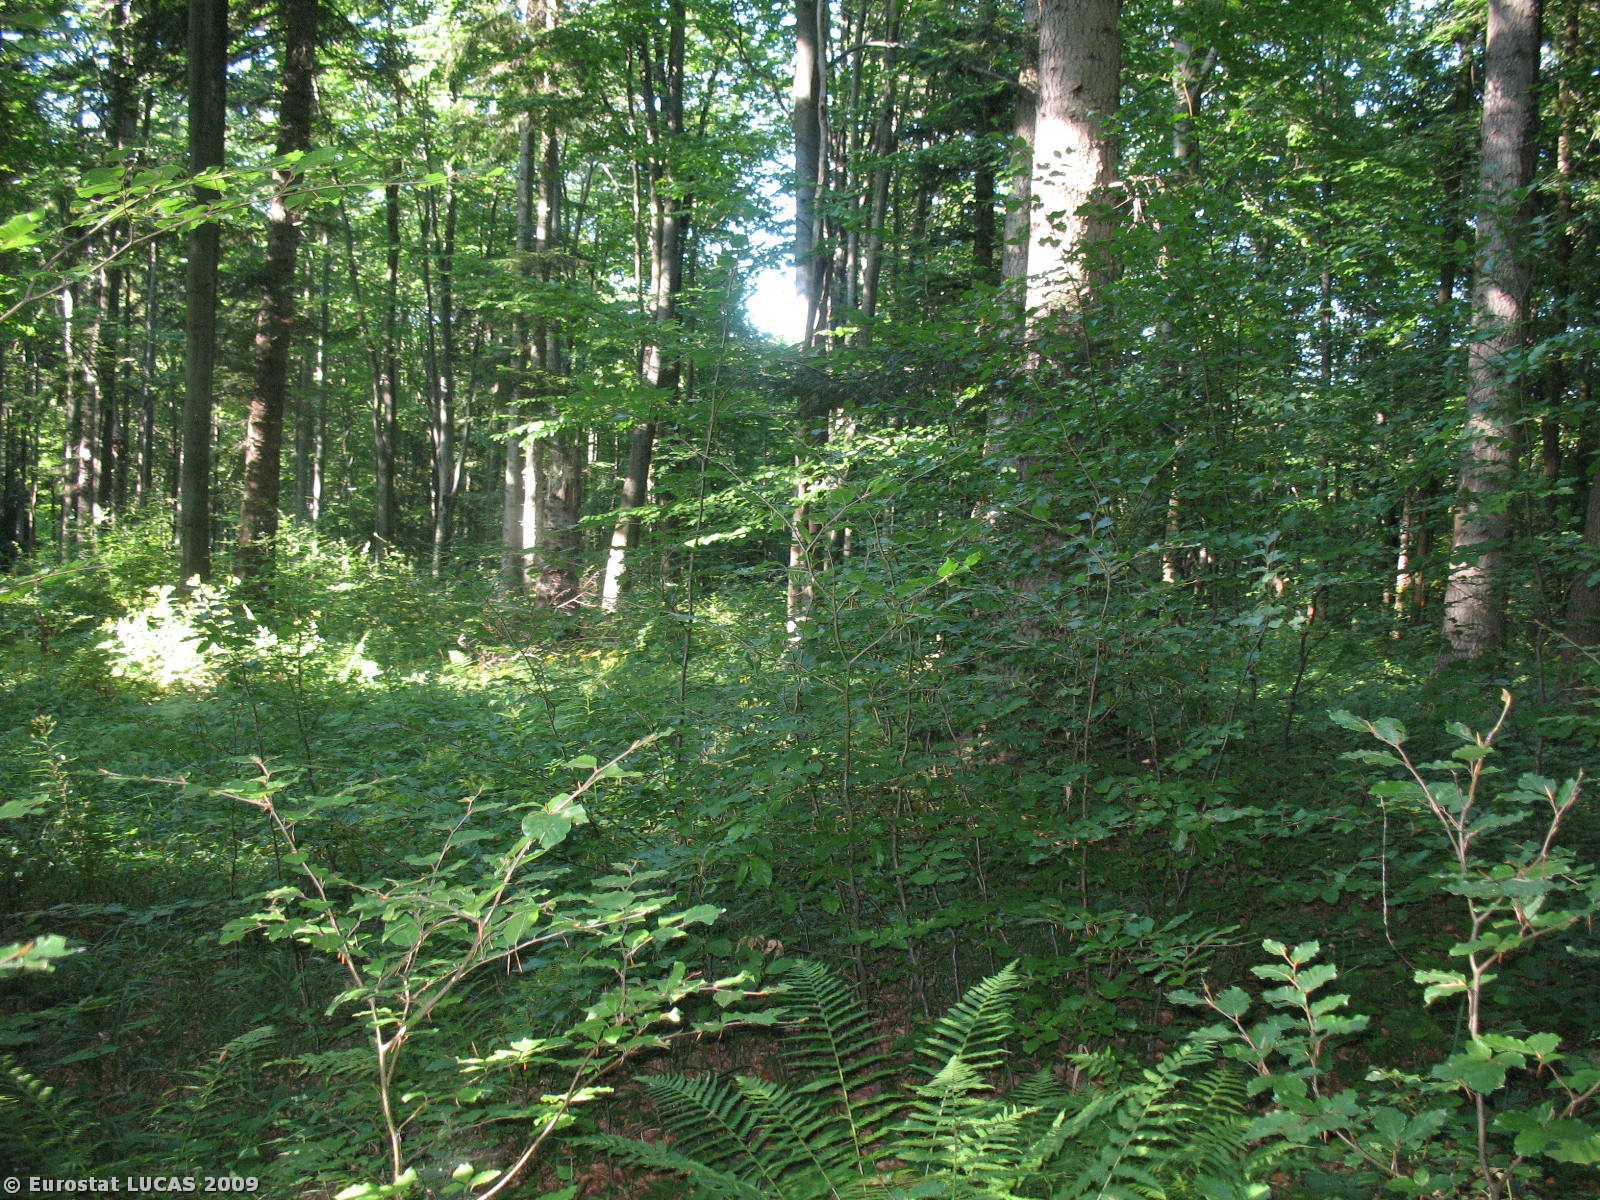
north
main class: Woodland
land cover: Mixed woodland
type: hemiboreal forest and nemoral coniferous forest and mixed broadleaved-coniferous forest
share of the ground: > 75 %
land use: Forestry
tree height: > 5 m
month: August
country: PL
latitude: 49.5542
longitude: 22.6039
